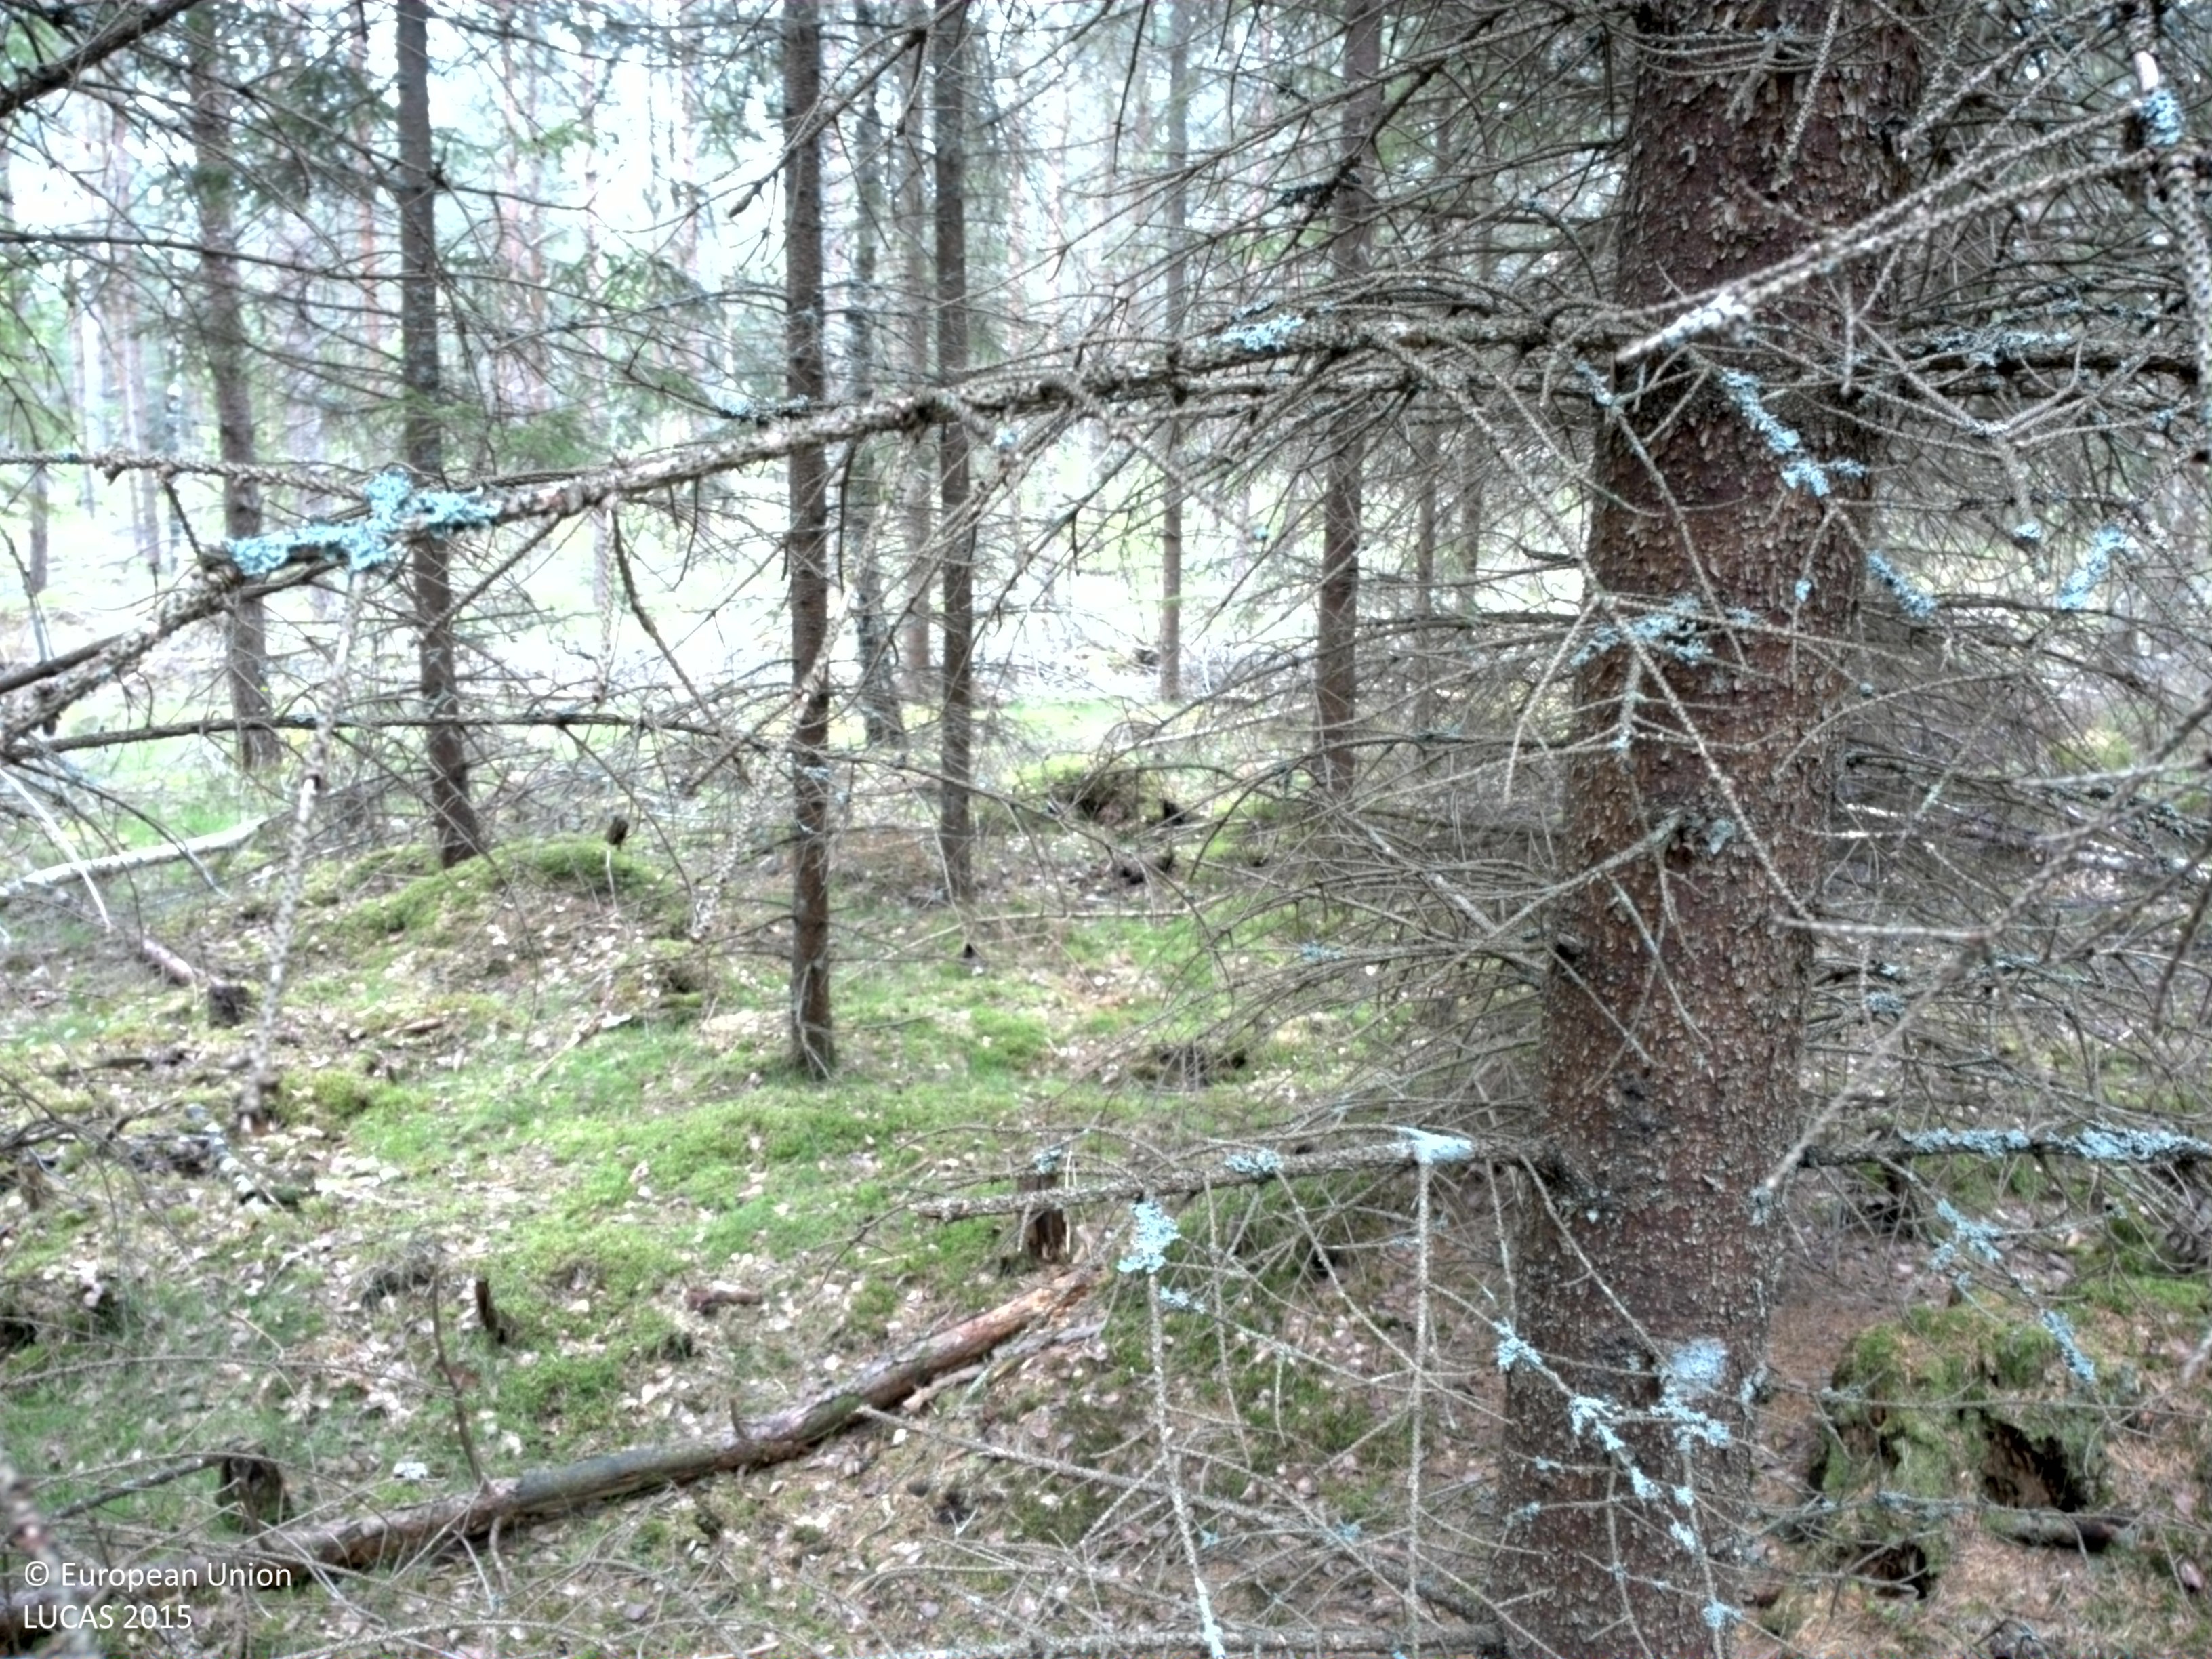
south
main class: Woodland
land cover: Spruce dominated coniferous woodland
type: boreal forest
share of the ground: > 75 %
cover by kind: coniferous forest trees 90 %, broadleaved forest trees 5 %, lichens and mosses 5 %
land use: Forestry
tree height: > 5 m
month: May
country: SE
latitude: 56.4167
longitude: 15.3968
